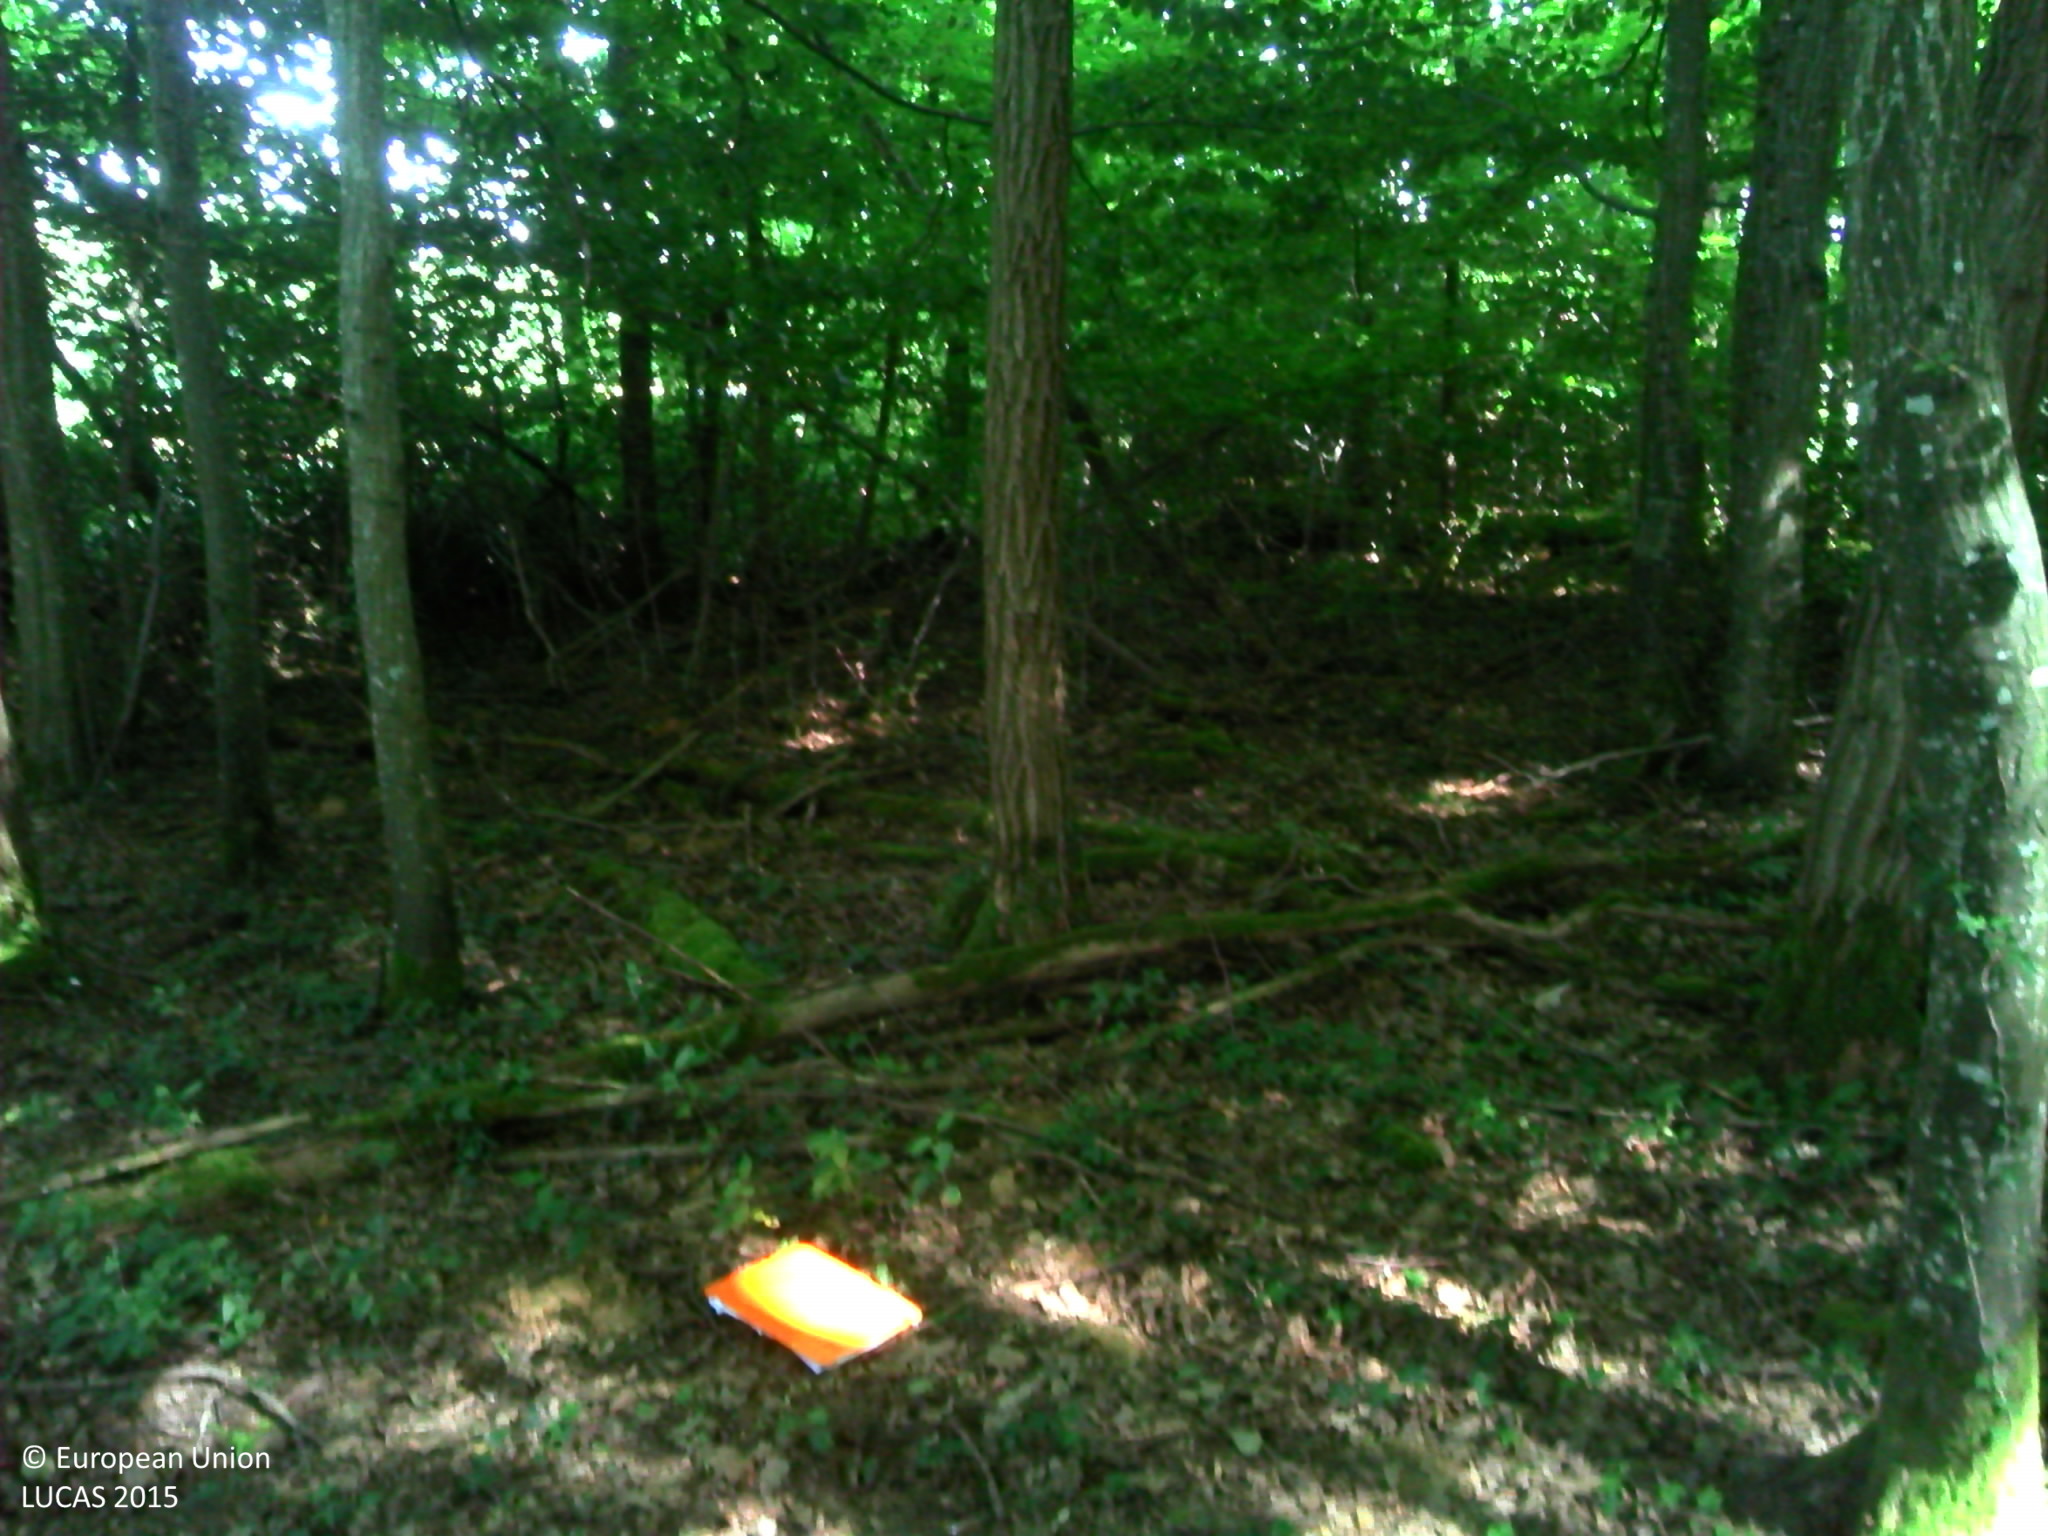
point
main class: Woodland
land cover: Broadleaved woodland
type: mesophytic deciduous forest
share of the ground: > 75 %
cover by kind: broadleaved forest trees 100 %
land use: Forestry
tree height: > 5 m
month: June
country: FR
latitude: 47.4904
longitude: 3.5058
